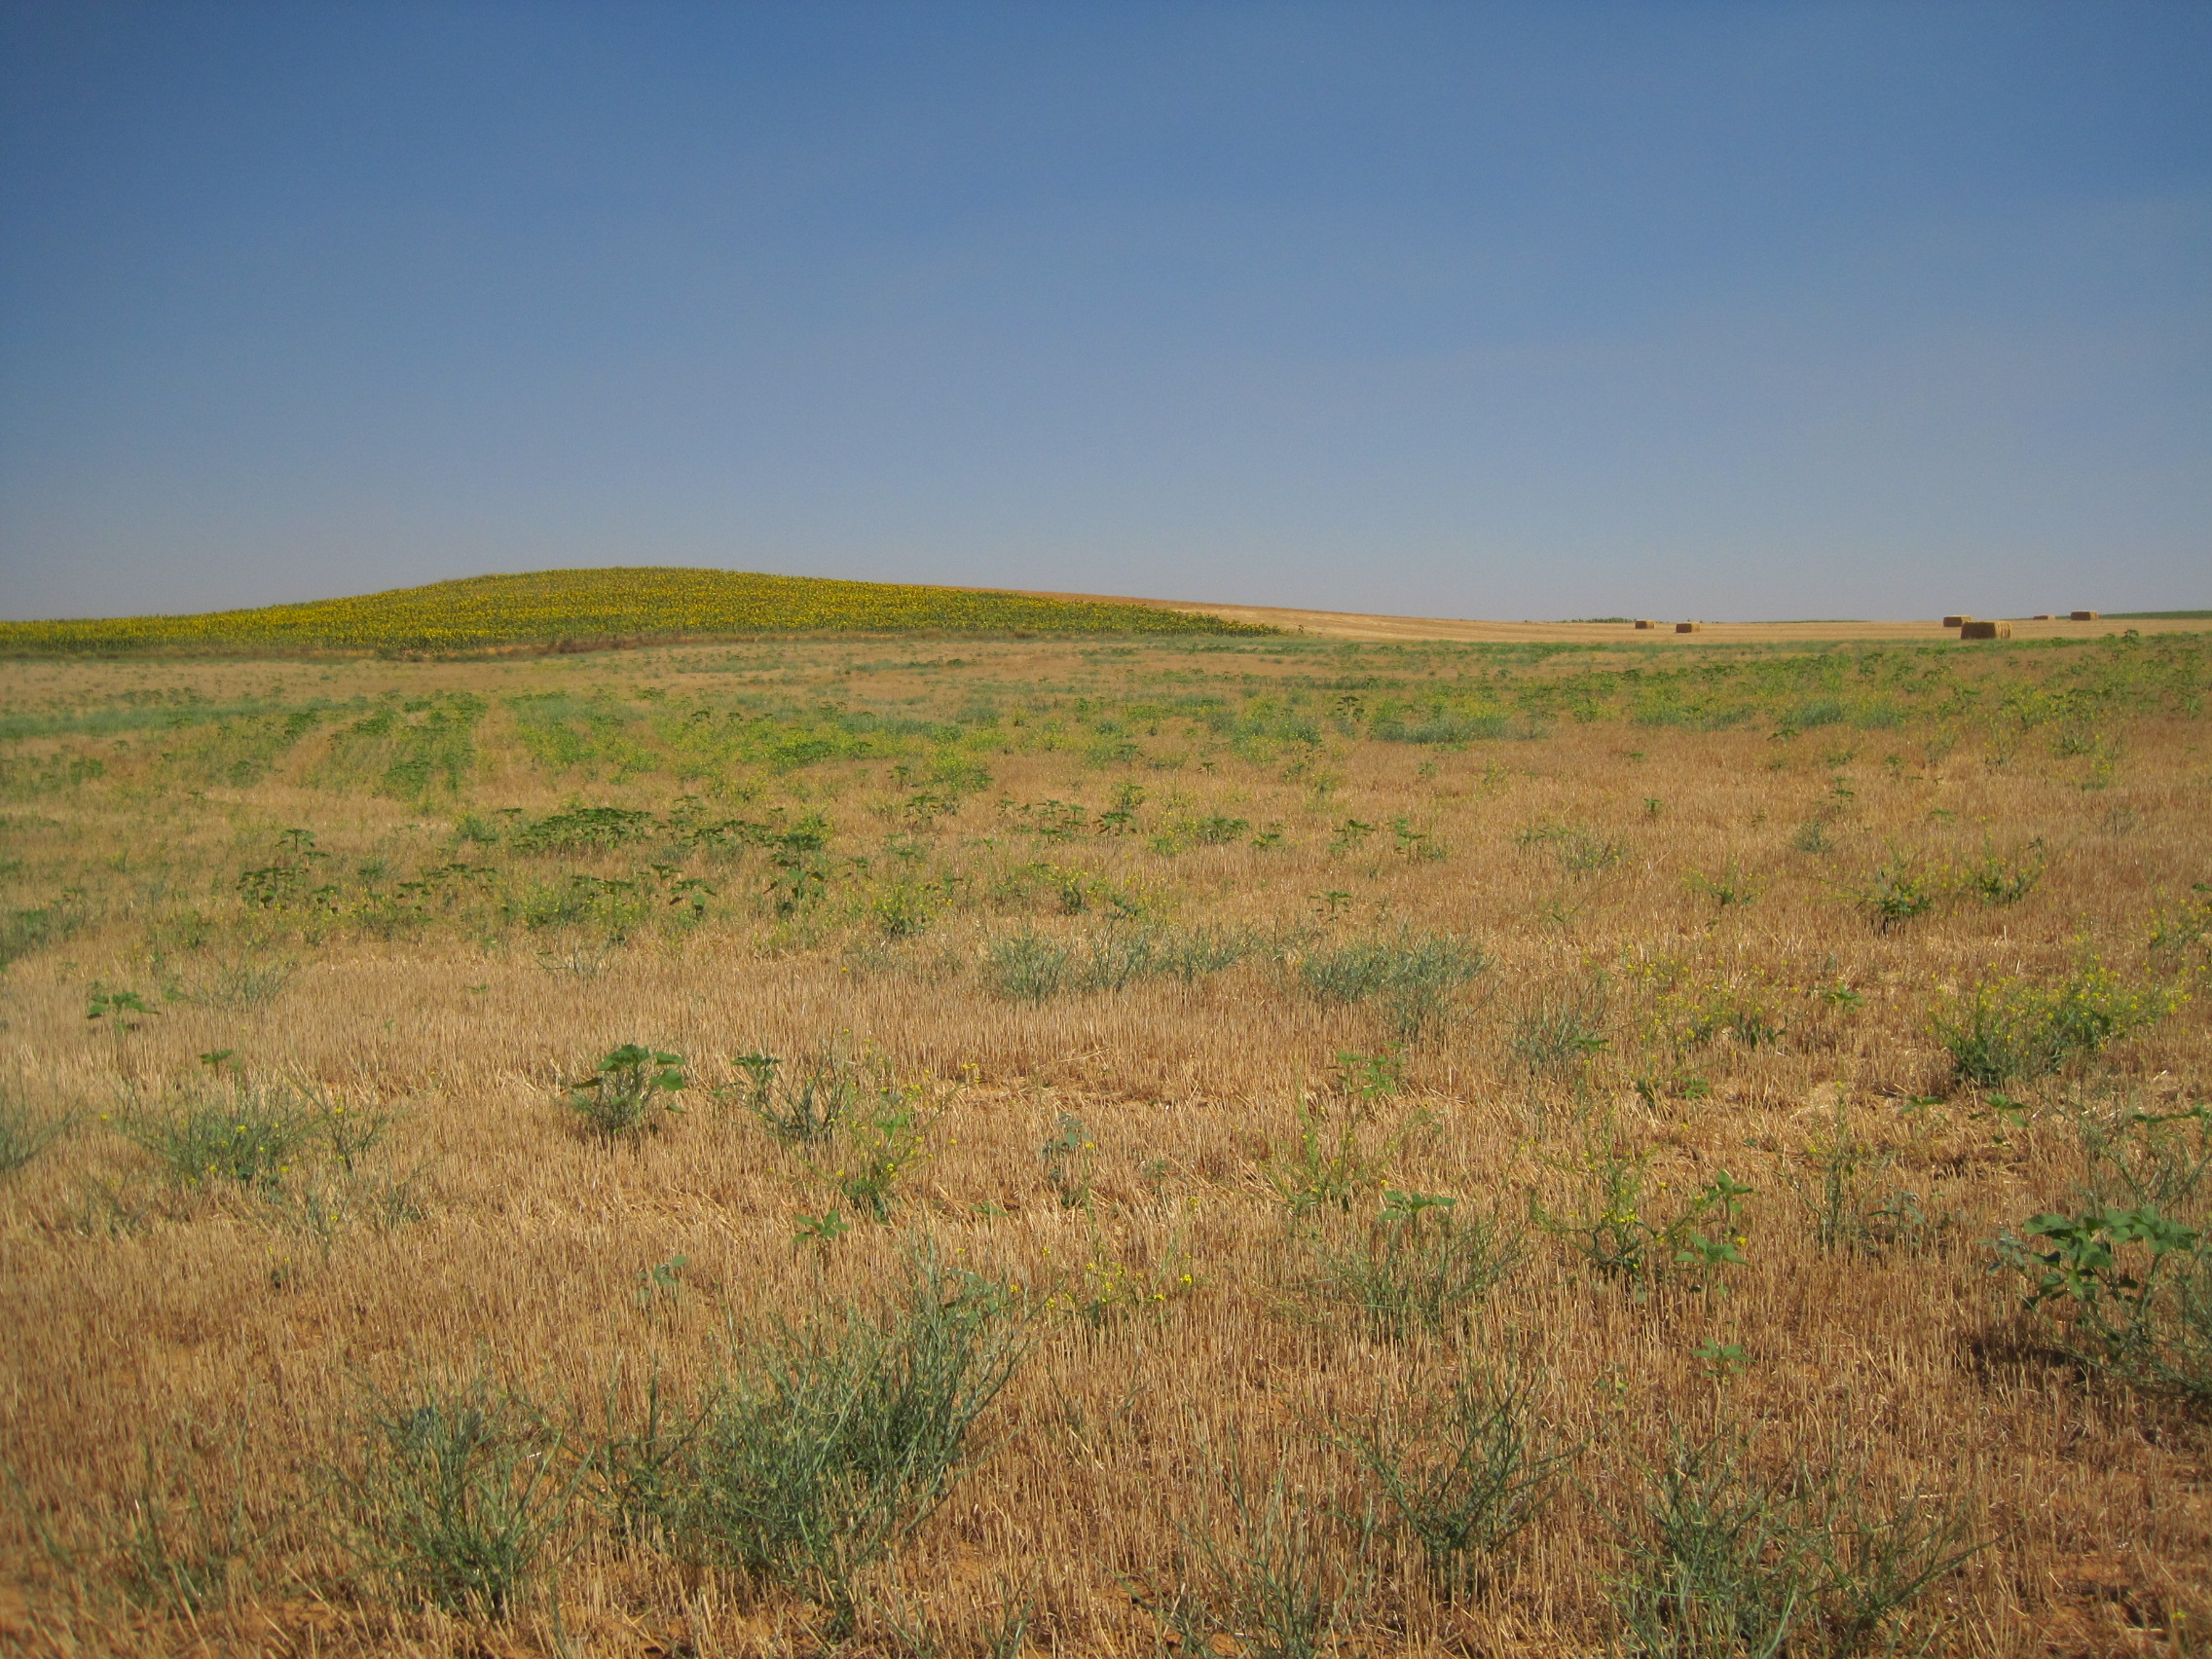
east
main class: Cropland
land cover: Barley
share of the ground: < 10 %
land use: Agriculture (excluding fallow land and kitchen gardens)
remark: Harvested field
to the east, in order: Barley; Grass margins; Sunflower; Grass margins; Barley
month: July
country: ES
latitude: 42.1235
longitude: -5.3152
